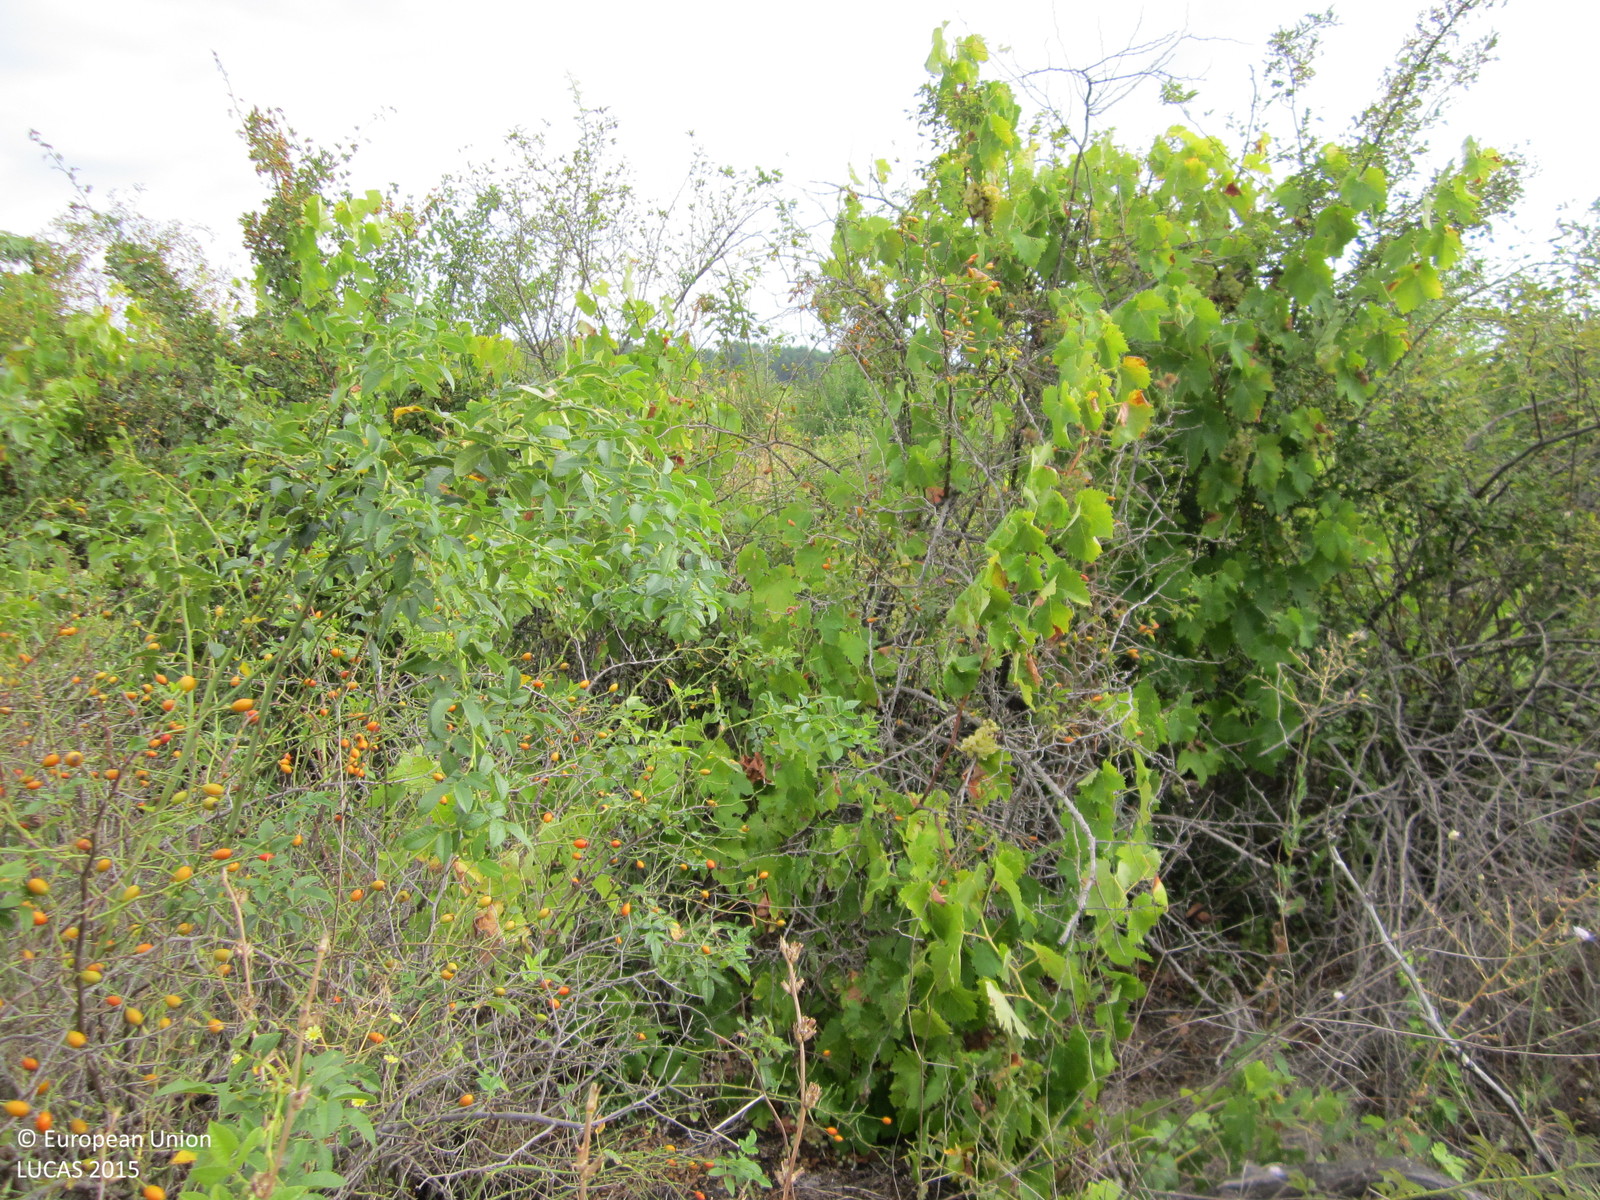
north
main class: Cropland
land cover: Vineyards
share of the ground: 25 - 50 %
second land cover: Shrubland without tree cover
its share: 25 - 50 %
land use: Abandoned areas
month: August
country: BG
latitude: 42.6146
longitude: 27.3658
